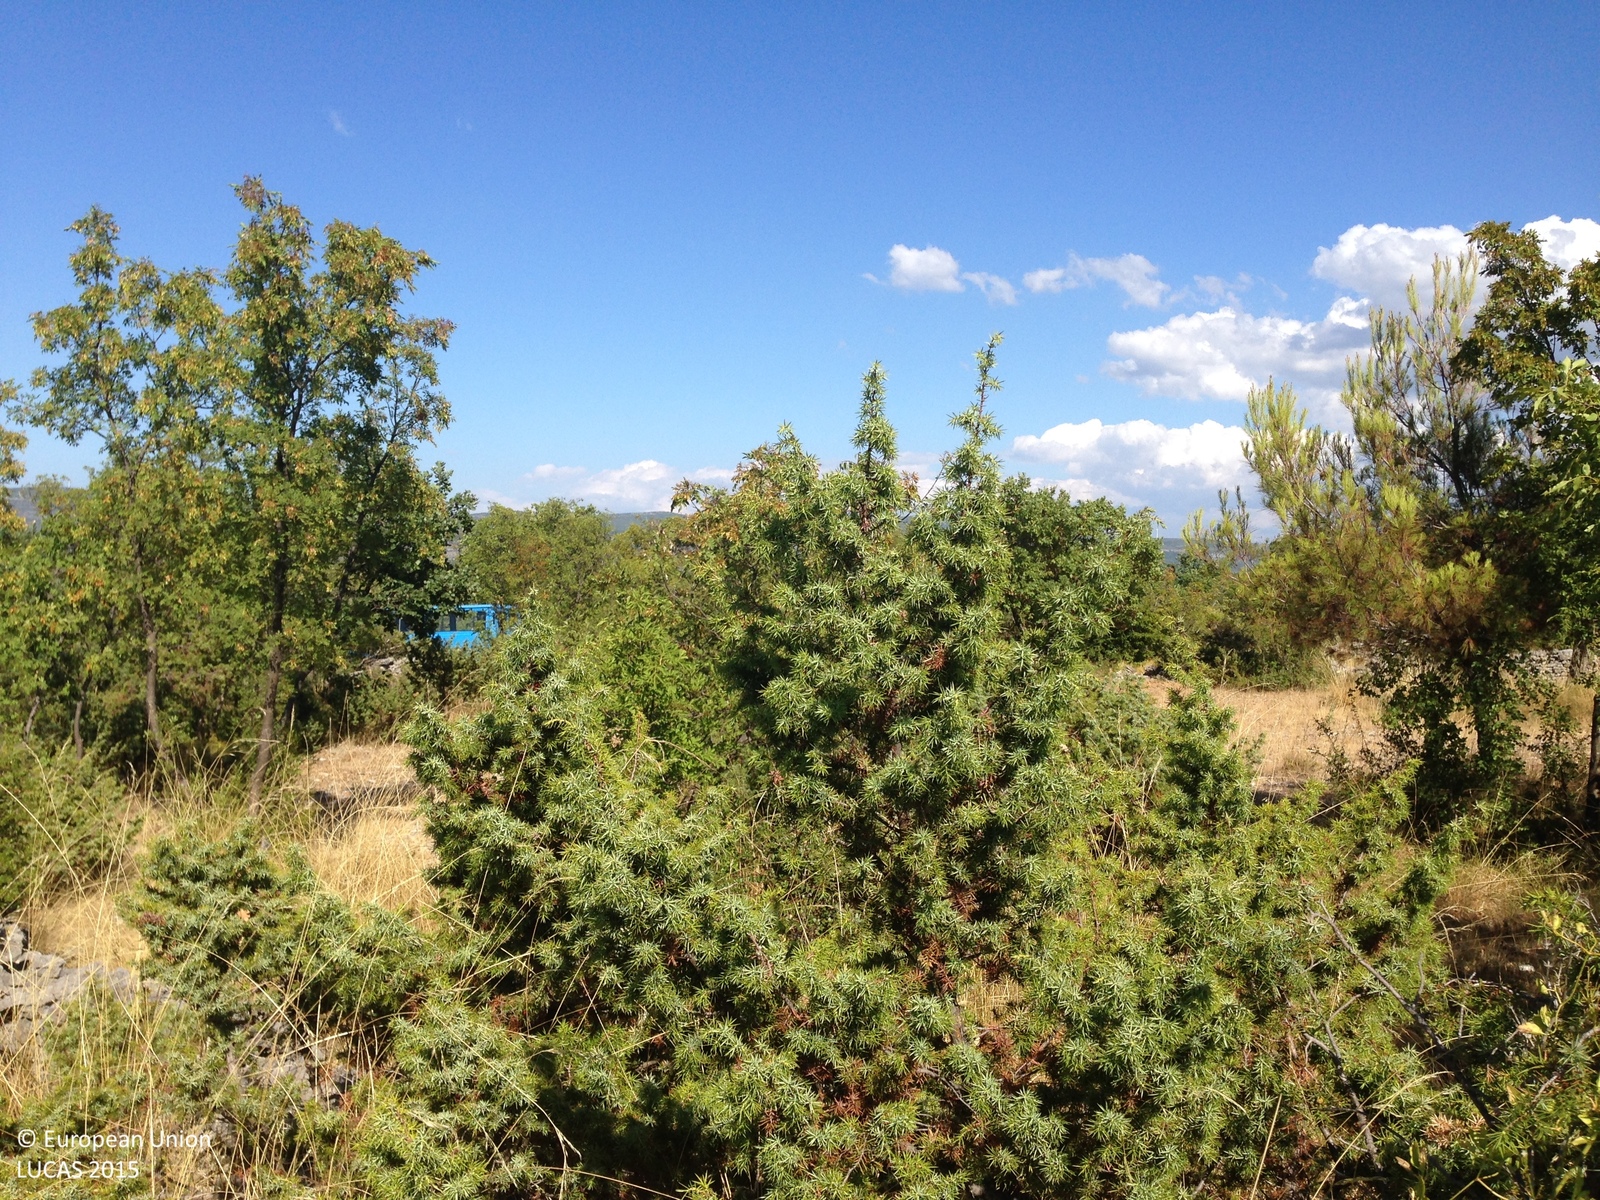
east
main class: Shrubland
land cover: Shrubland with sparse tree cover
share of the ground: 50 - 75 %
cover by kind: shrubs 65 %, herbaceous plants 15 %, unconsolidated bare surface 10 %, broadleaved forest trees 5 %, consolidated bare surface 5 %
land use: Semi-natural and natural areas not in use
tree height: < 5 m
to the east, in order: Shrubland with sparse tree cover; Tracks; Shrubland with sparse tree cover; Dry stone walls; Shrubland with sparse tree cover; Dry stone walls; Shrubland with sparse tree cover; Grassland with sparse tree/shrub cover; Grassland without tree/shrub cover; Tracks; Grassland without tree/shrub cover; Olive groves; Shrubland with sparse tree cover
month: July
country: HR
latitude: 44.1282
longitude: 15.5787
